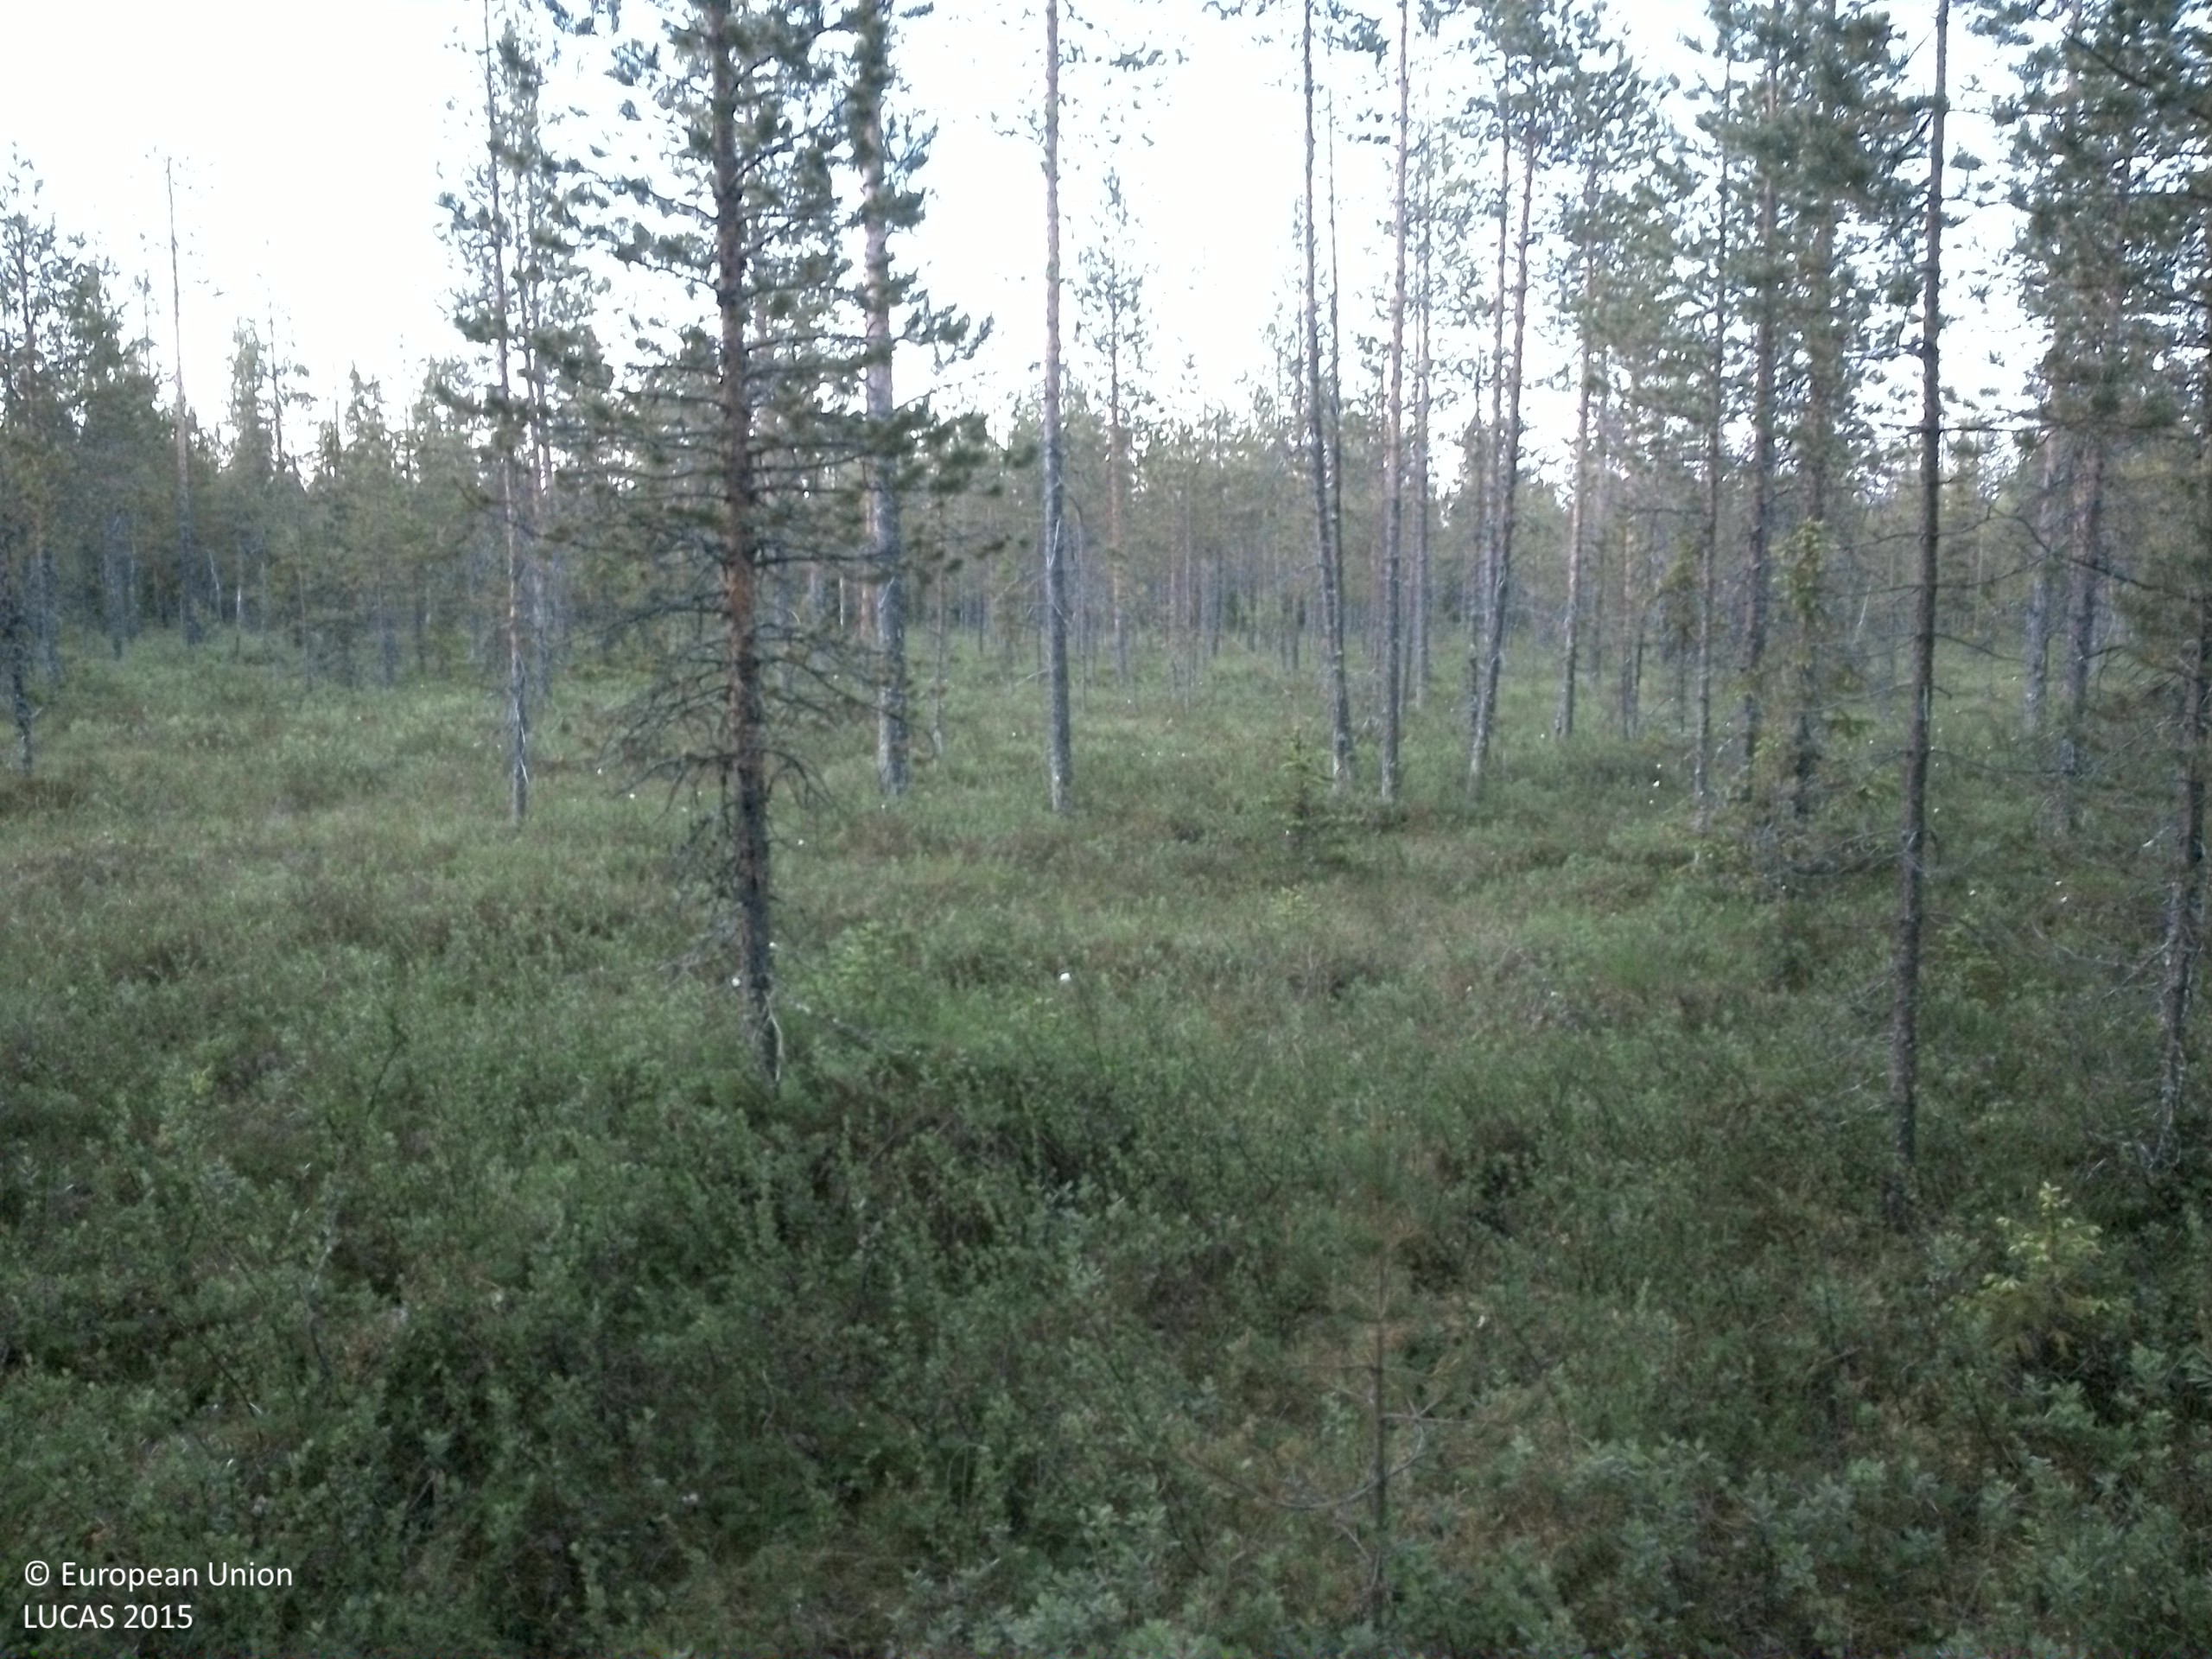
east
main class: Woodland
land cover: Pine dominated coniferous woodland
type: boreal forest
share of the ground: 25 - 50 %
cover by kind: shrubs 55 %, coniferous forest trees 20 %, lichens and mosses 15 %, broadleaved forest trees 5 %, herbaceous plants 5 %
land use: Forestry
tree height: > 5 m
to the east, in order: Pine dominated coniferous woodland; Pine dominated mixed woodland; Spruce dominated mixed woodland
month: July
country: SE
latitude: 64.3028
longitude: 16.8930
